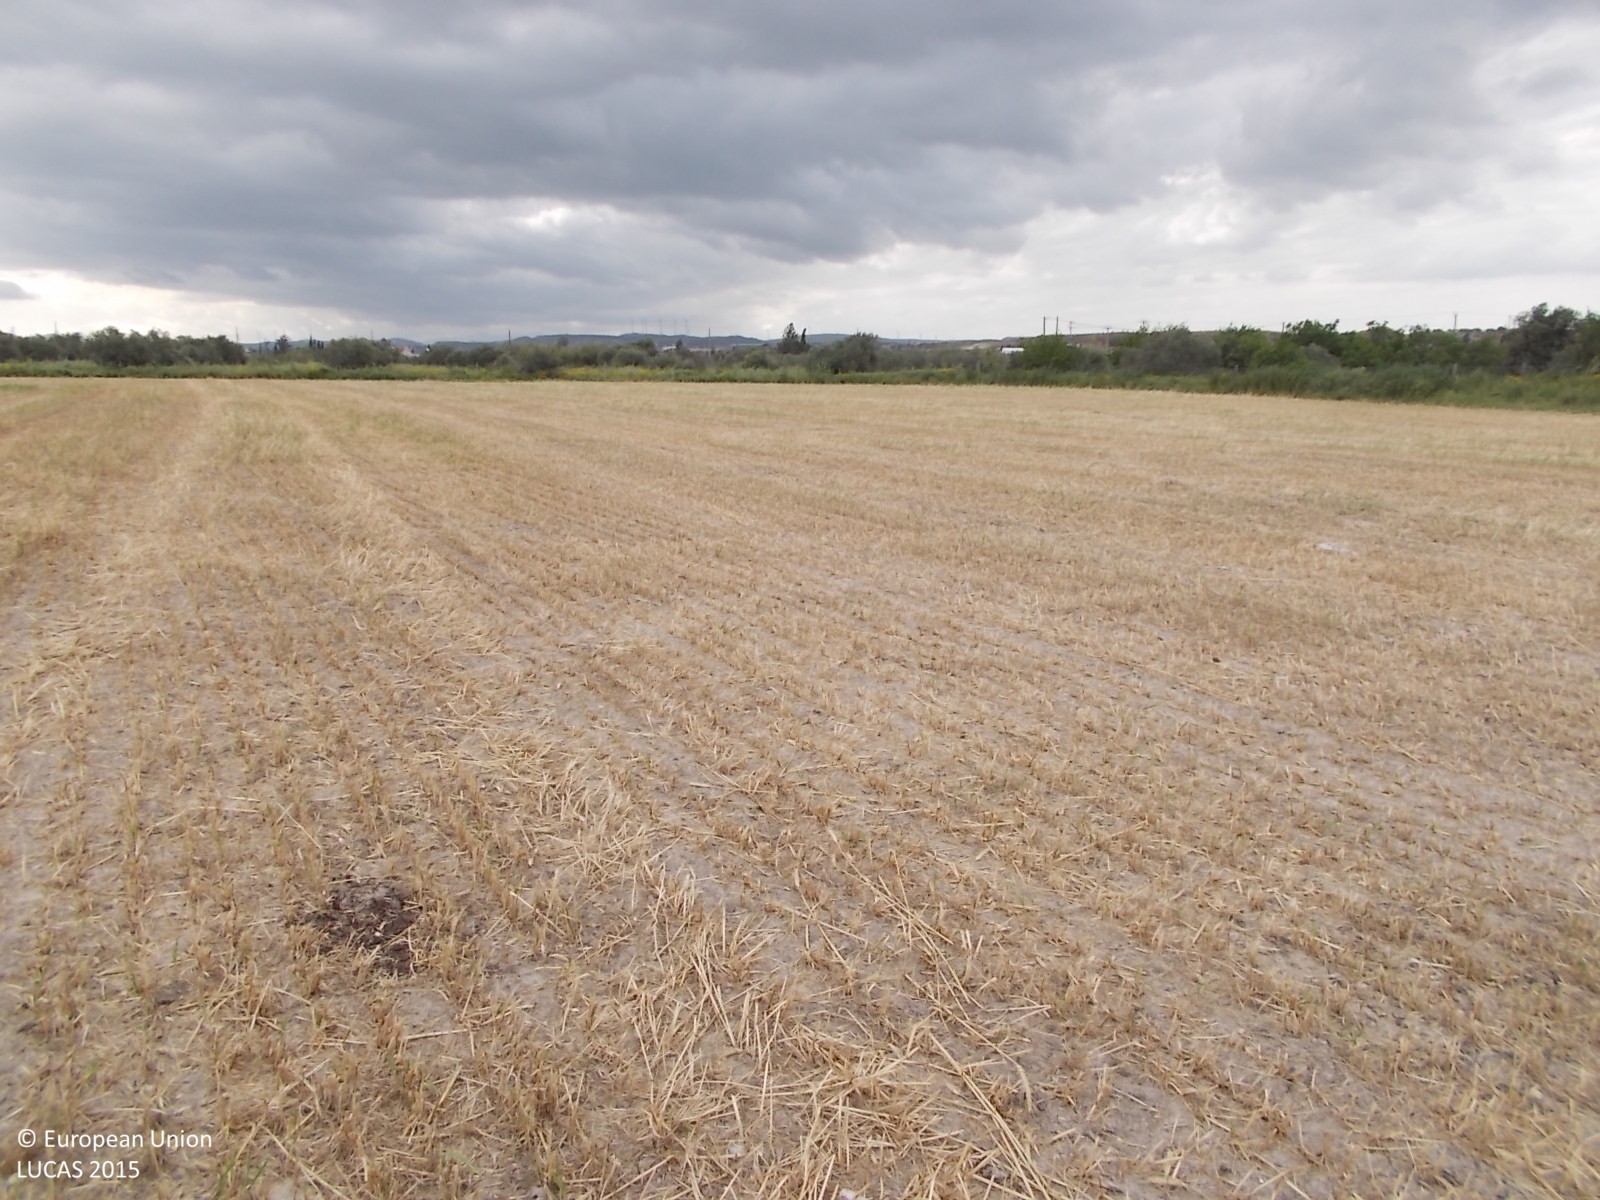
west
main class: Cropland
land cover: Common wheat
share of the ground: < 10 %
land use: Agriculture (excluding fallow land and kitchen gardens)
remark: Harvested field
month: April
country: CY
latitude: 34.9578
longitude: 33.5992
